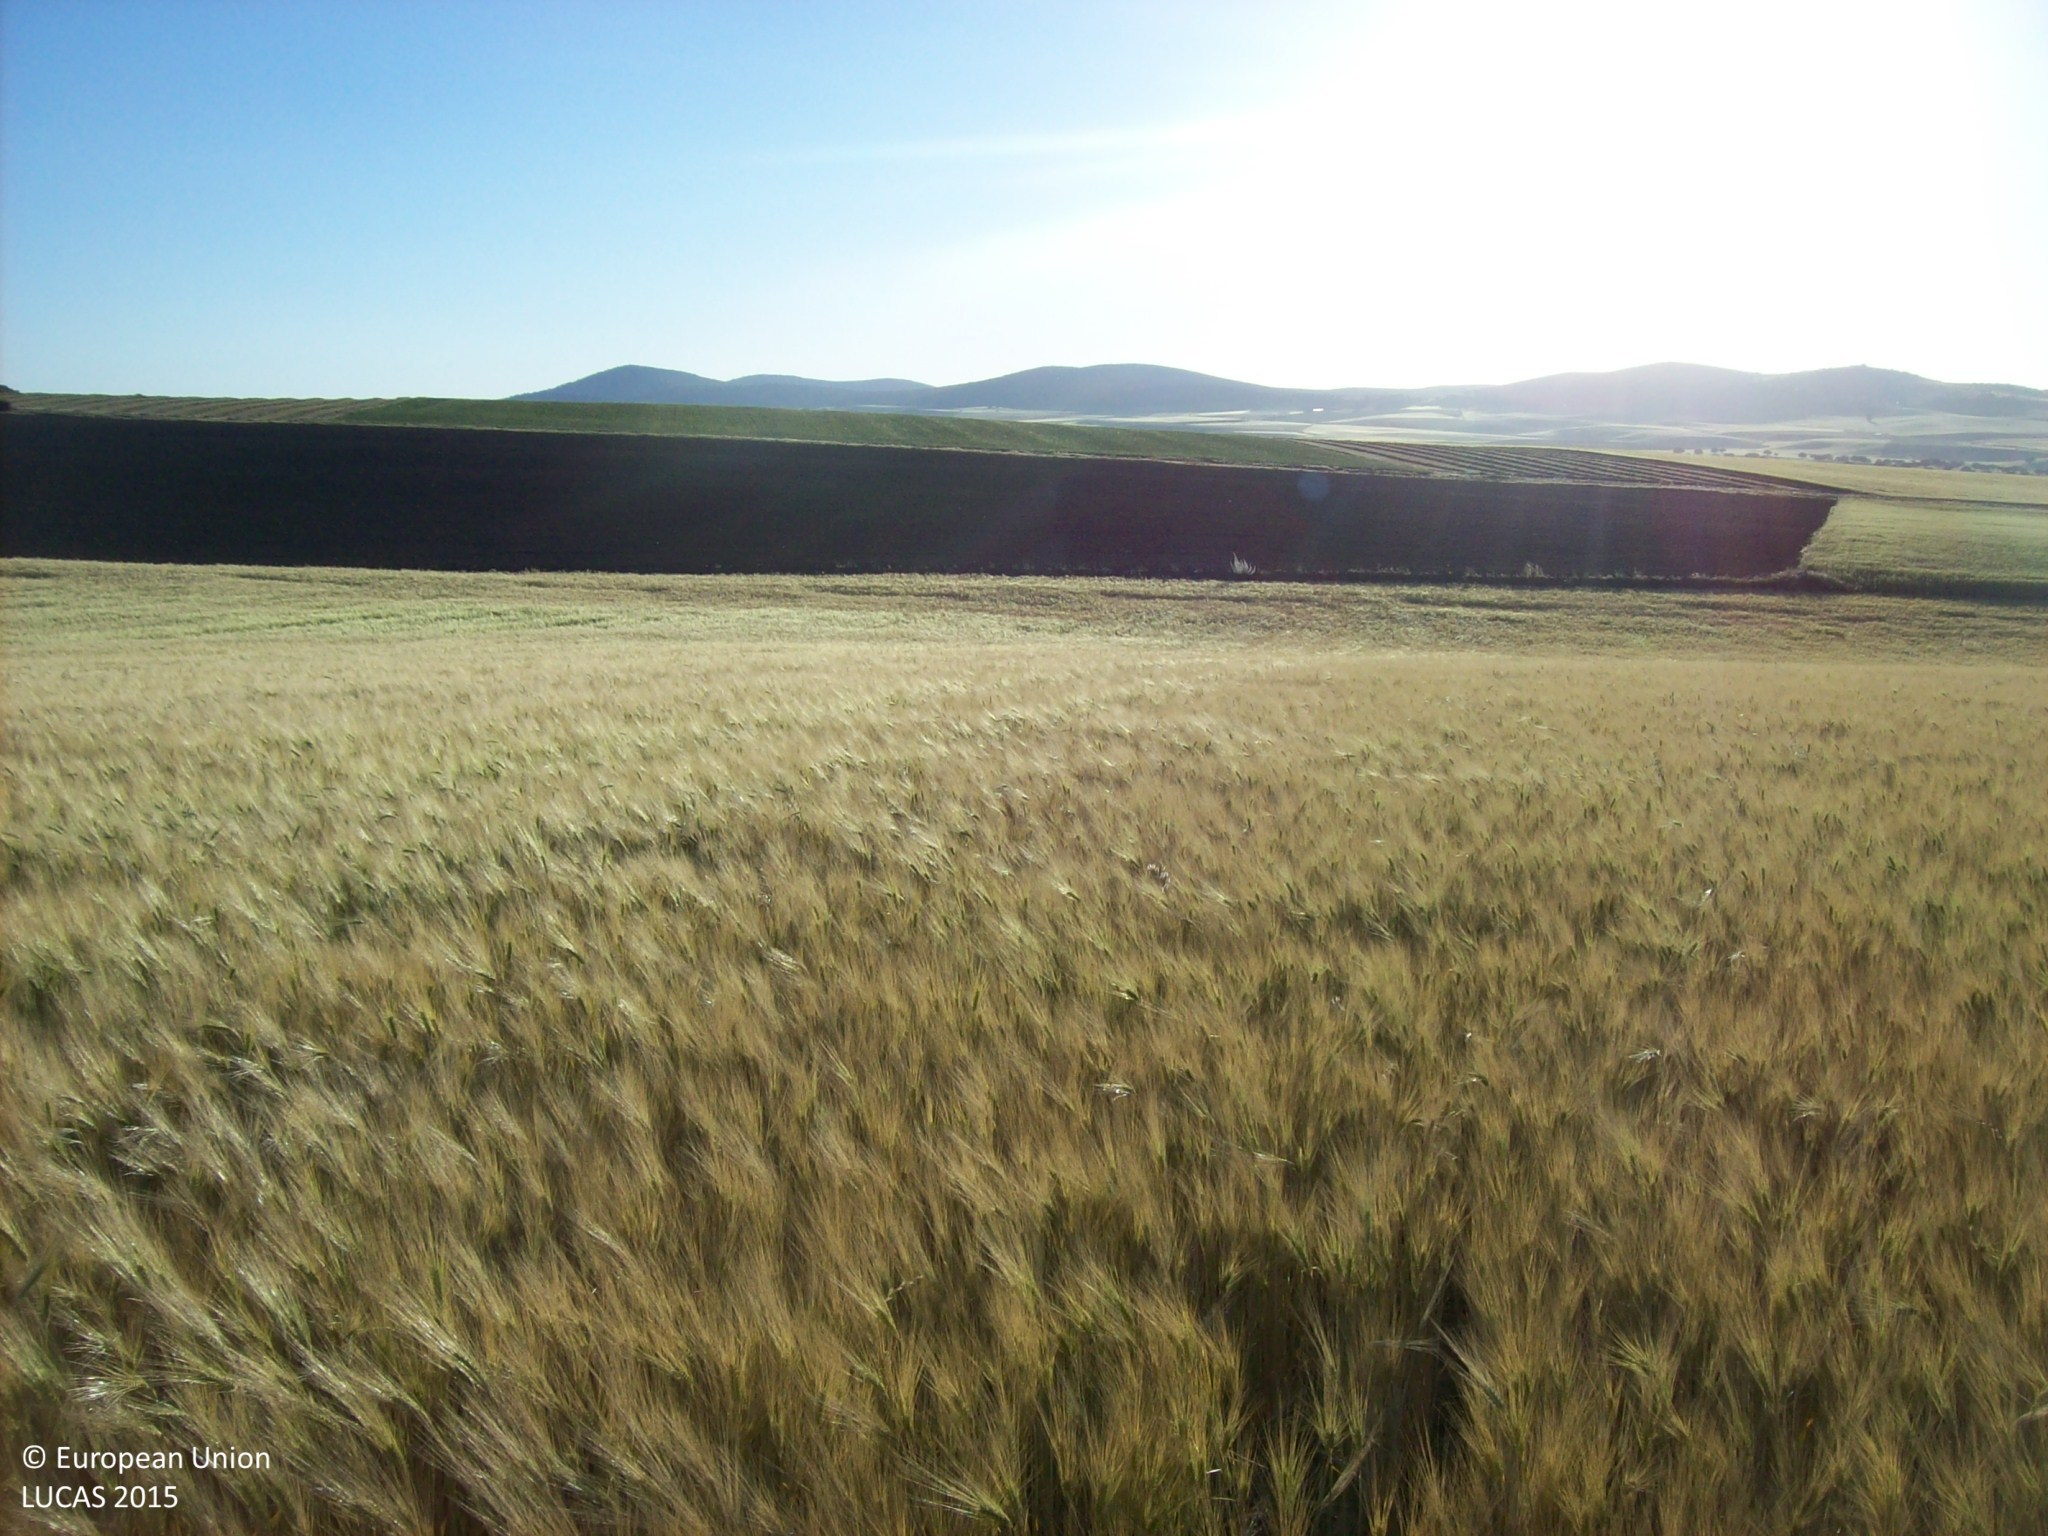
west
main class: Cropland
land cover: Barley
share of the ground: > 75 %
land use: Agriculture (excluding fallow land and kitchen gardens)
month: May
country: ES
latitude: 40.7559
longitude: -4.9019
